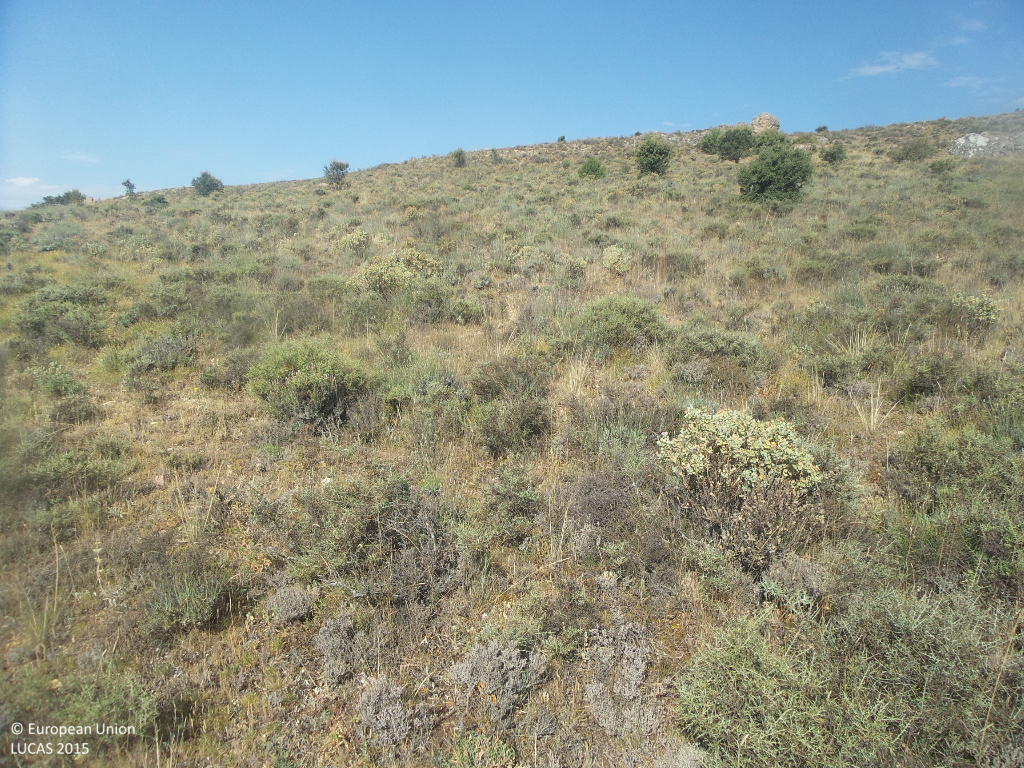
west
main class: Shrubland
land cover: Shrubland without tree cover
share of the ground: 50 - 75 %
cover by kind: shrubs 60 %, herbaceous plants 20 %, lichens and mosses 10 %, unconsolidated bare surface 10 %
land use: Semi-natural and natural areas not in use
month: July
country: ES
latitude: 41.1298
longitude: -2.7683
